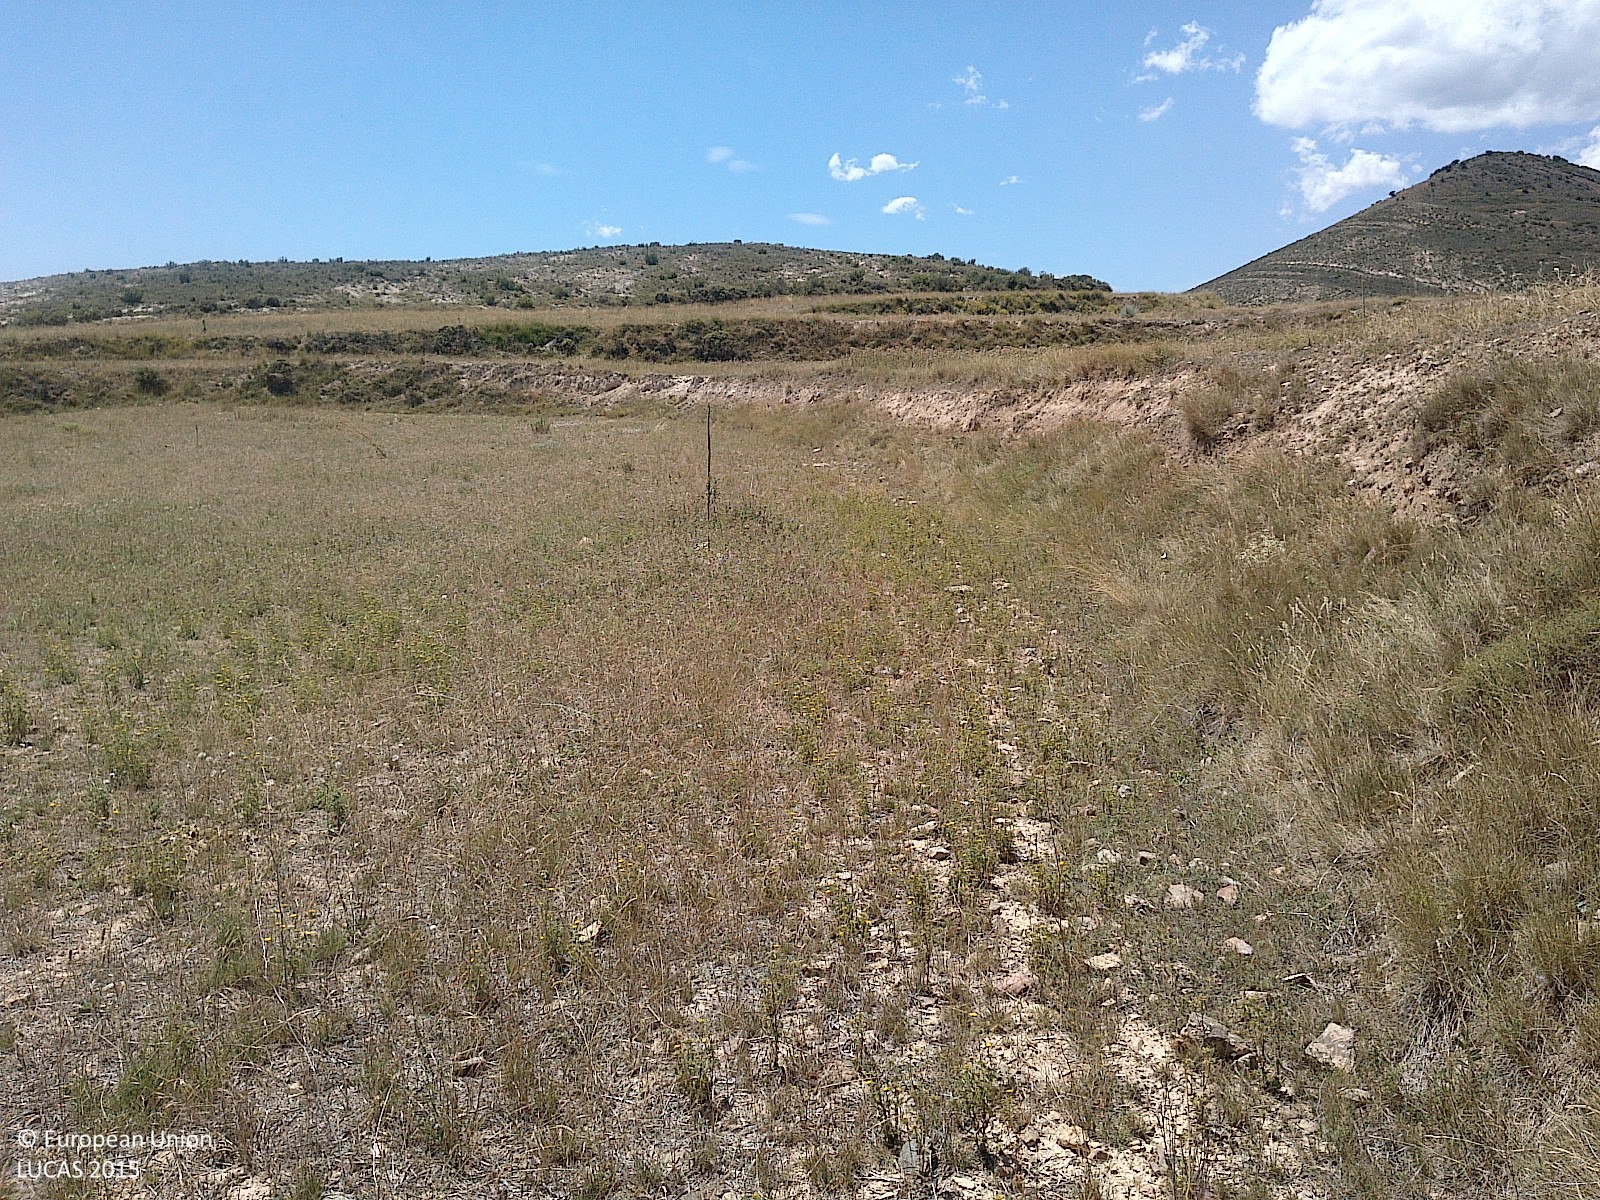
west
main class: Grassland
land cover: Spontaneously vegetated surfaces
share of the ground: > 75 %
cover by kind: herbaceous plants 80 %, unconsolidated bare surface 20 %
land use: Fallow land
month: July
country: ES
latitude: 41.9871
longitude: -2.0456
